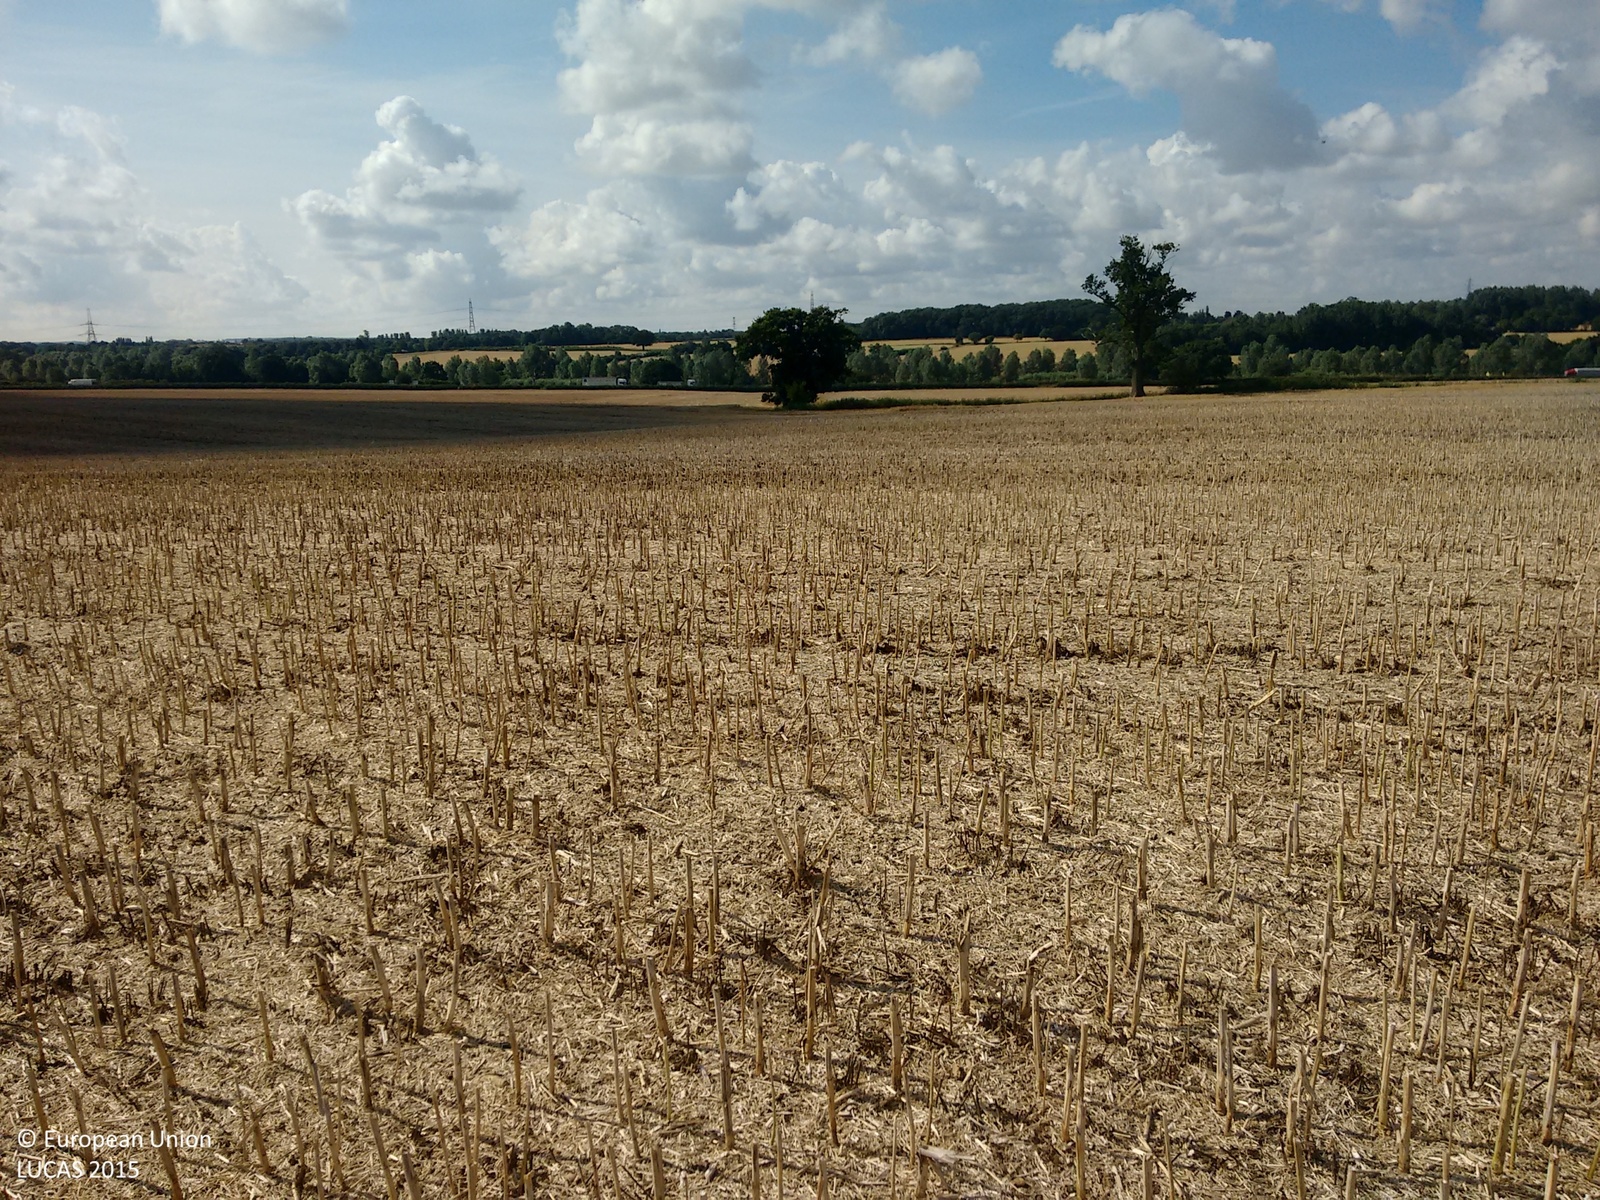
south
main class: Cropland
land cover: Rape and turnip rape
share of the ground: 25 - 50 %
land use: Agriculture (excluding fallow land and kitchen gardens)
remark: Harvested field
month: July
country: GB
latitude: 51.8797
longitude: 0.6327
